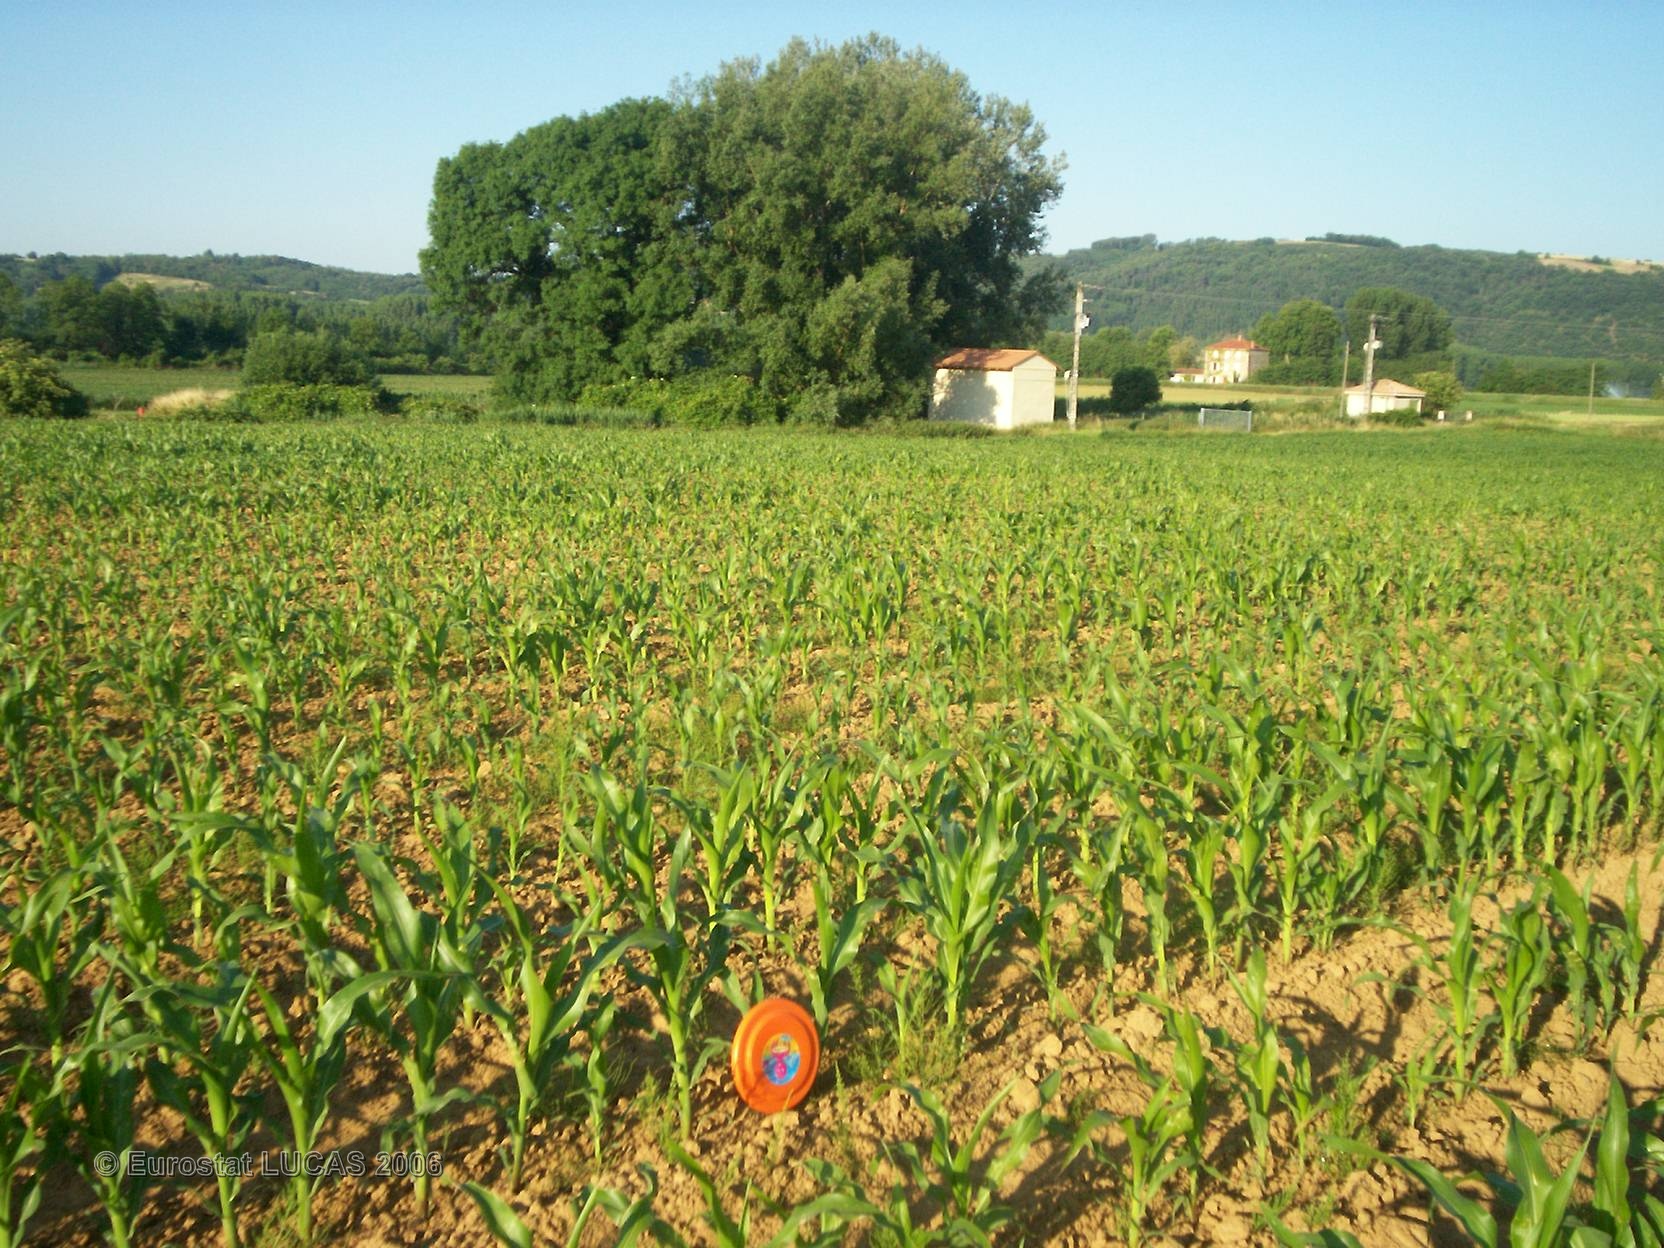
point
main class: Cropland
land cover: Maize
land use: Agriculture (excluding fallow land and kitchen gardens)
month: June
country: FR
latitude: 45.1814
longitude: 4.8764
